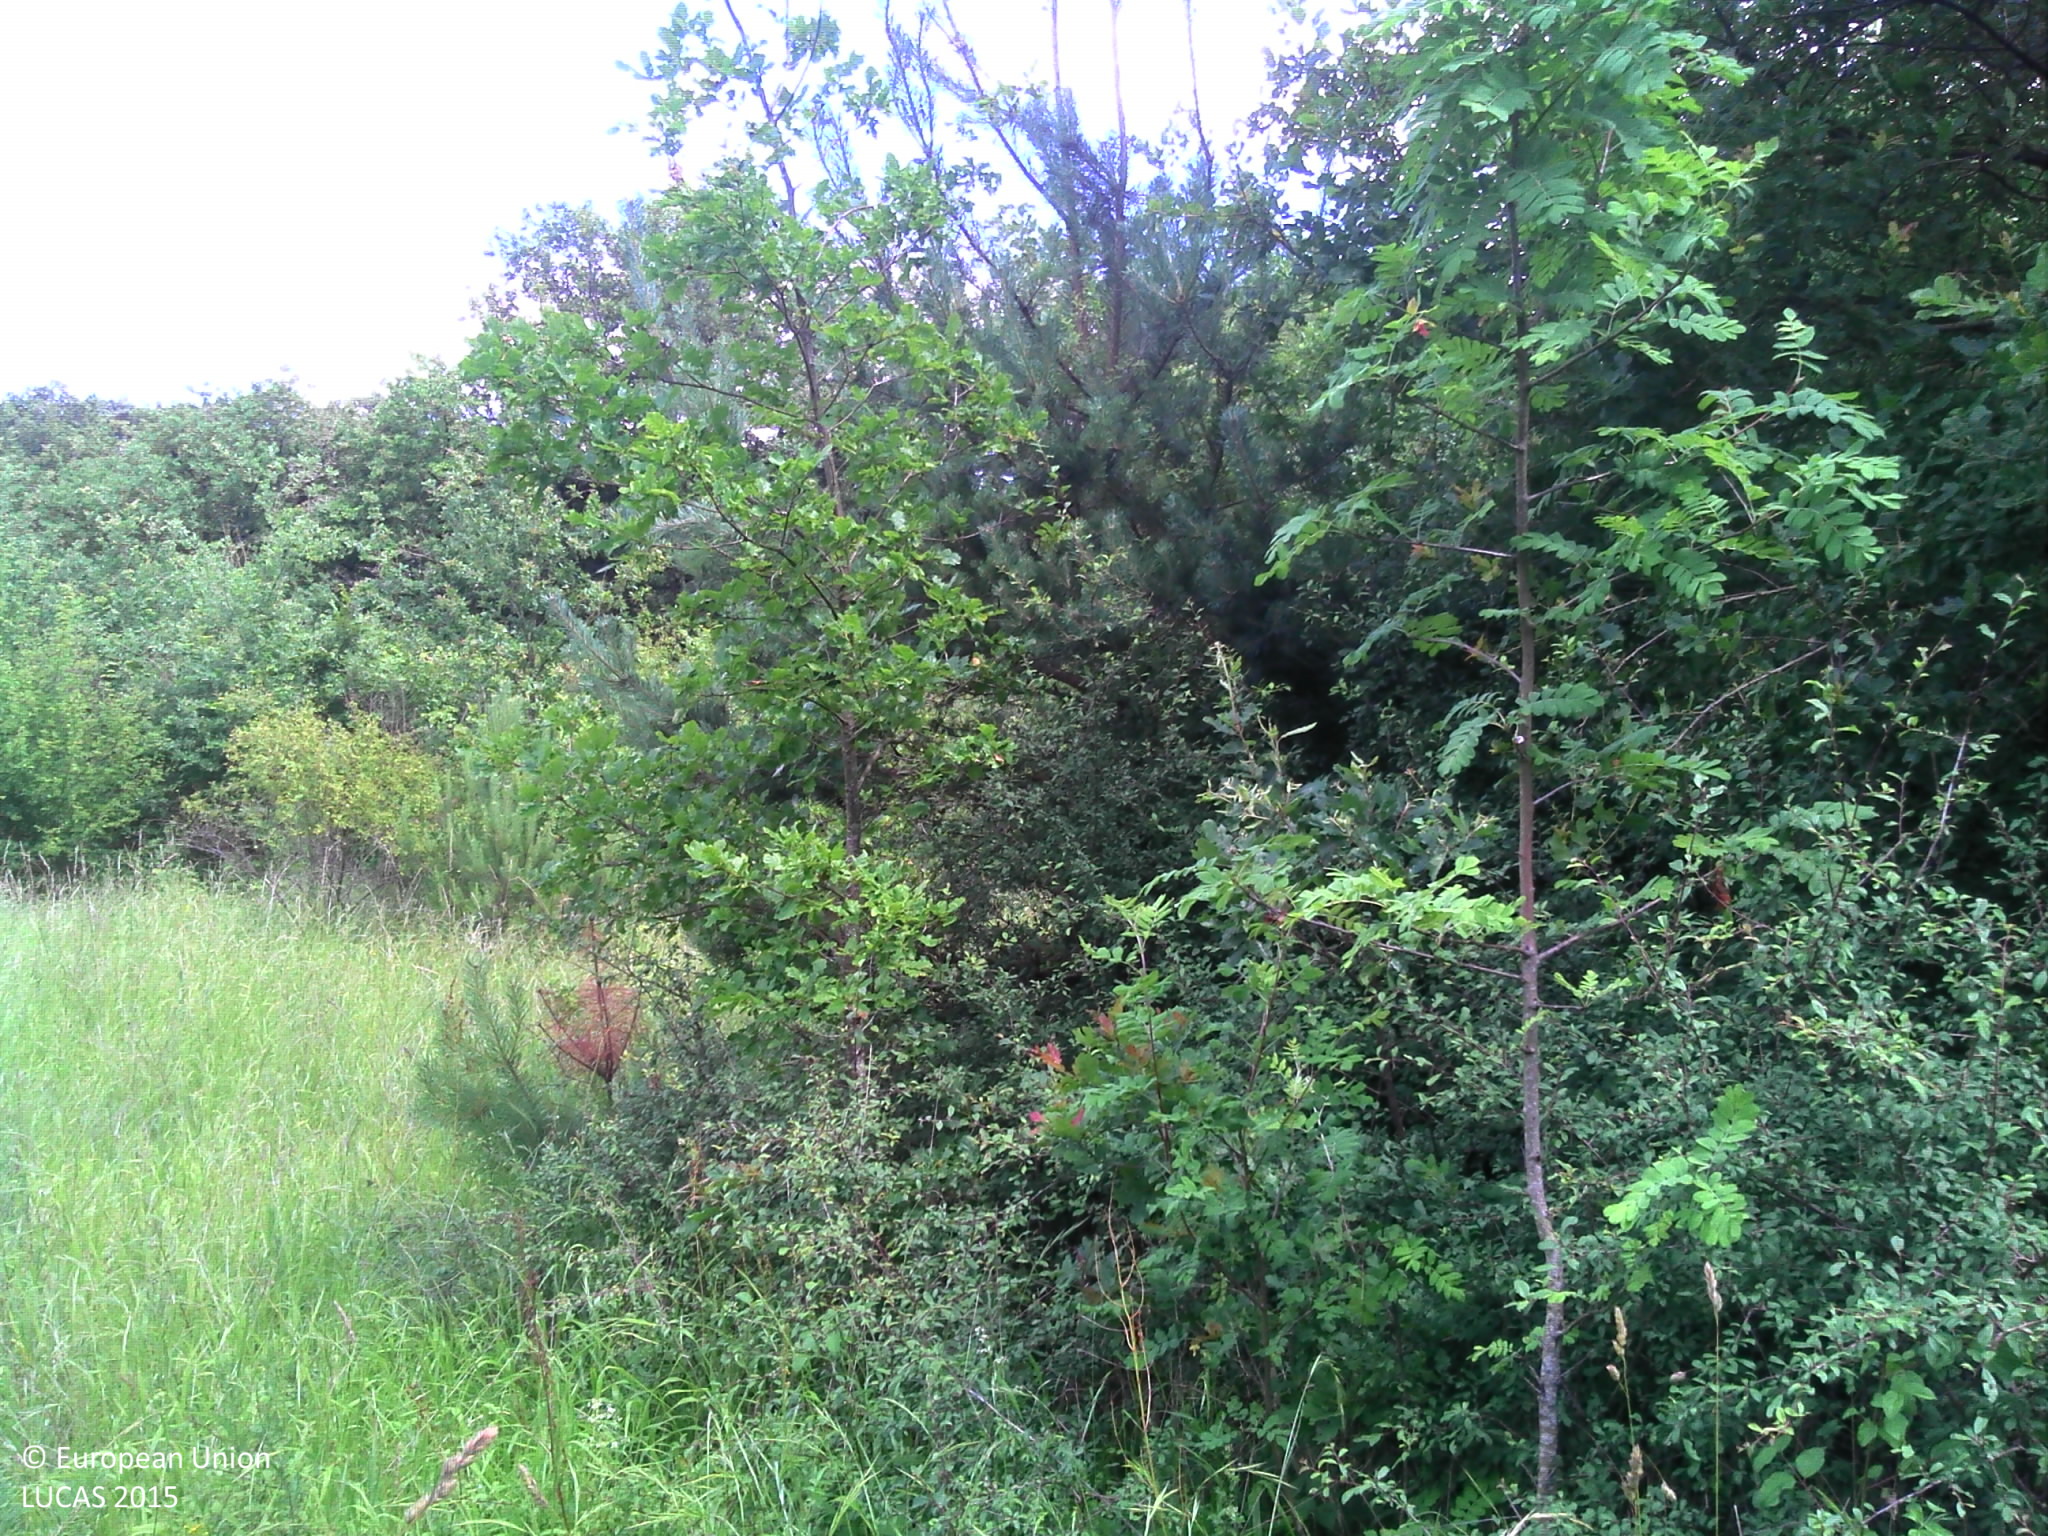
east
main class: Woodland
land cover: Broadleaved woodland
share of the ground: > 75 %
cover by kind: broadleaved forest trees 50 %, shrubs 35 %, herbaceous plants 10 %, coniferous forest trees 5 %
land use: Forestry
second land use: Residential
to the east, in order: Broadleaved woodland; Ditches and canals; Grass margins; Paved roads, cycling and walking lanes; Grass margins; Ditches and canals; Grass margins; Broadleaved woodland; Shrubland with sparse tree cover; Electric lines; Shrubland with sparse tree cover; Broadleaved woodland; Shrubland with sparse tree cover; Fences; Grass margins; Tracks; Grass margins; Electric lines; Fences; Grassland with sparse tree/shrub cover; Artificial constructions in urban areas
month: June
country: FR
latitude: 47.3141
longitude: 0.8143
